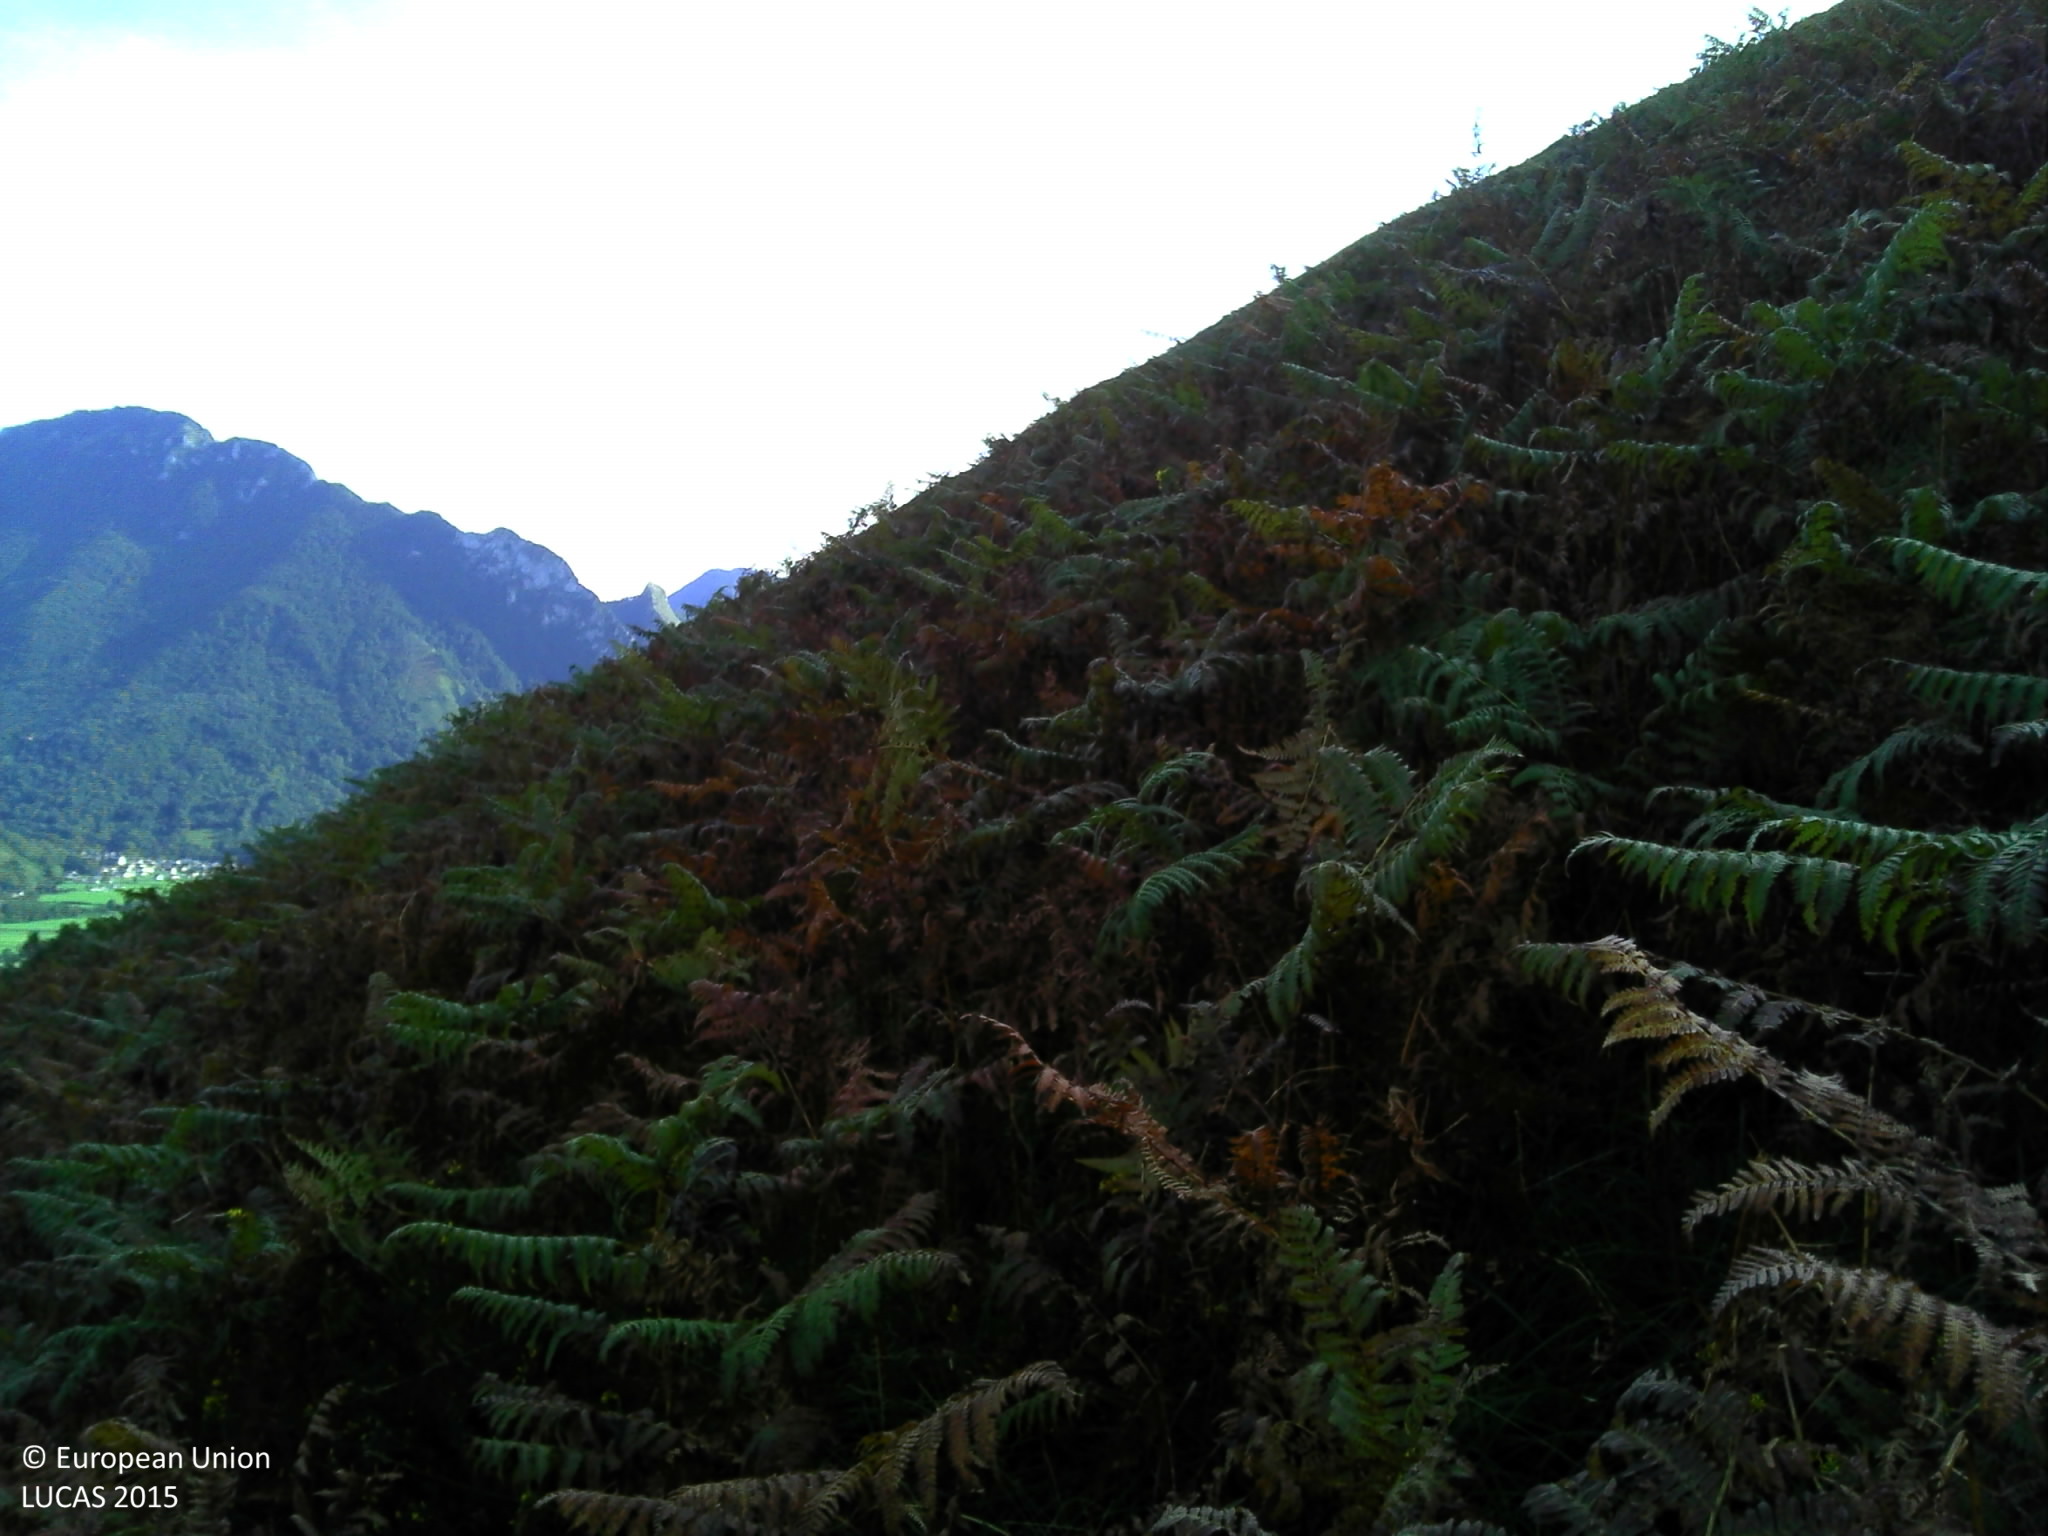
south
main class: Grassland
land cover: Grassland without tree/shrub cover
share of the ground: > 75 %
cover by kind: herbaceous plants 95 %, shrubs 5 %
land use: Agriculture (excluding fallow land and kitchen gardens)
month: September
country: FR
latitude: 43.0041
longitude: -0.6181
